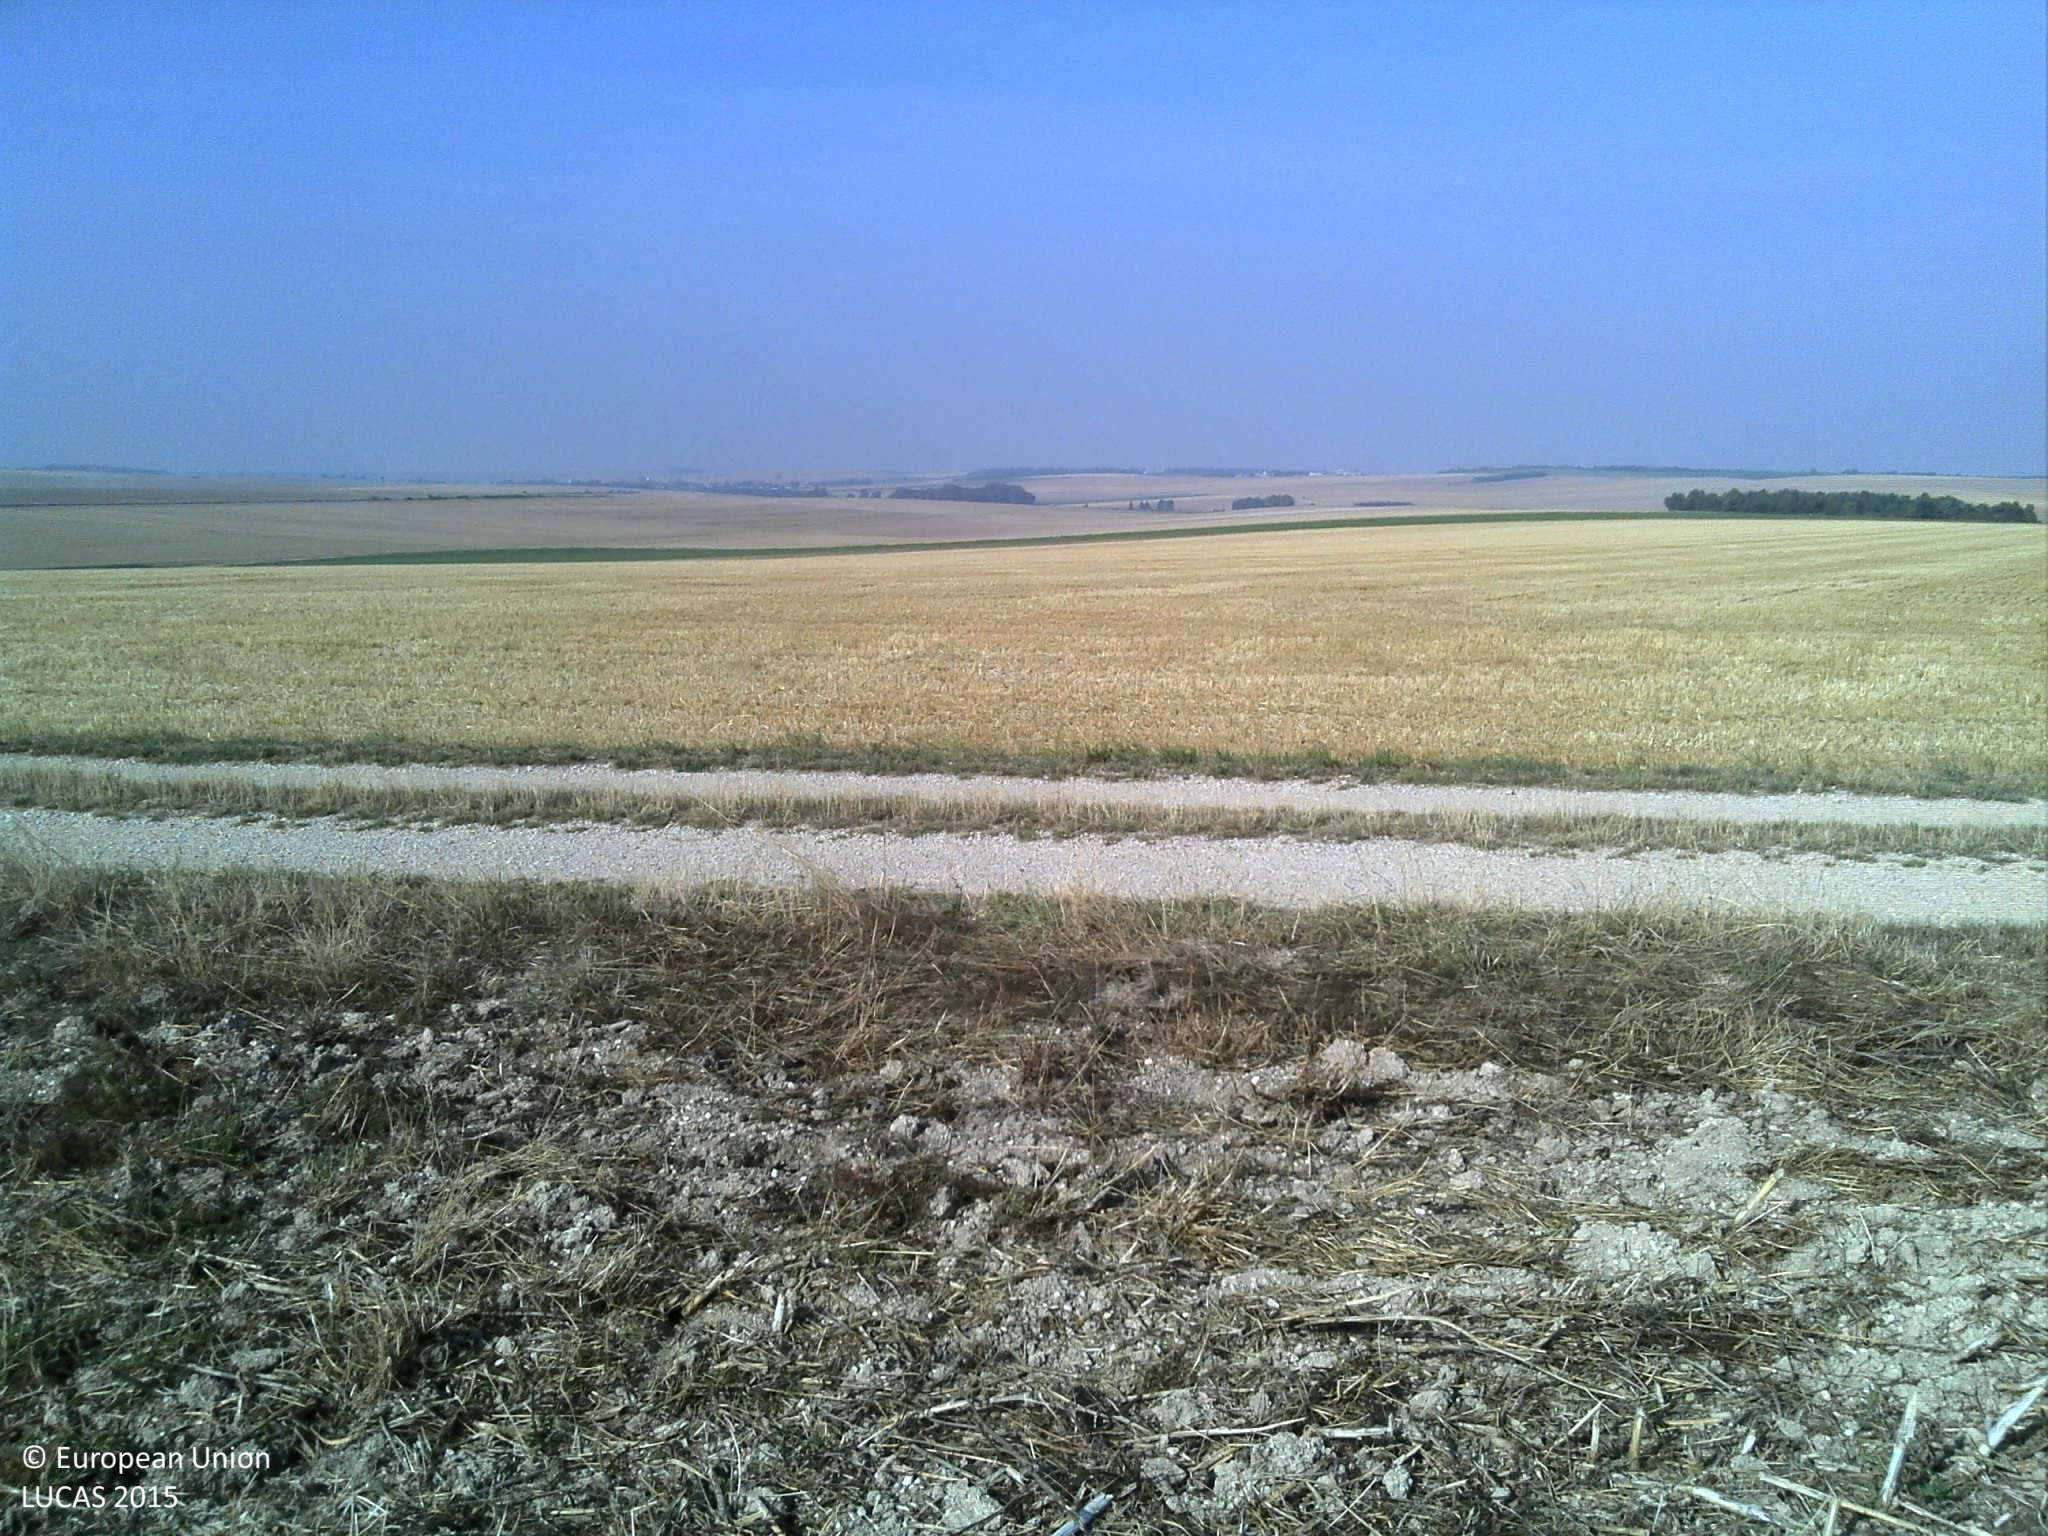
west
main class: Cropland
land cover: Rape and turnip rape
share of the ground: > 75 %
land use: Agriculture (excluding fallow land and kitchen gardens)
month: August
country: FR
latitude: 48.9376
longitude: 4.5772
